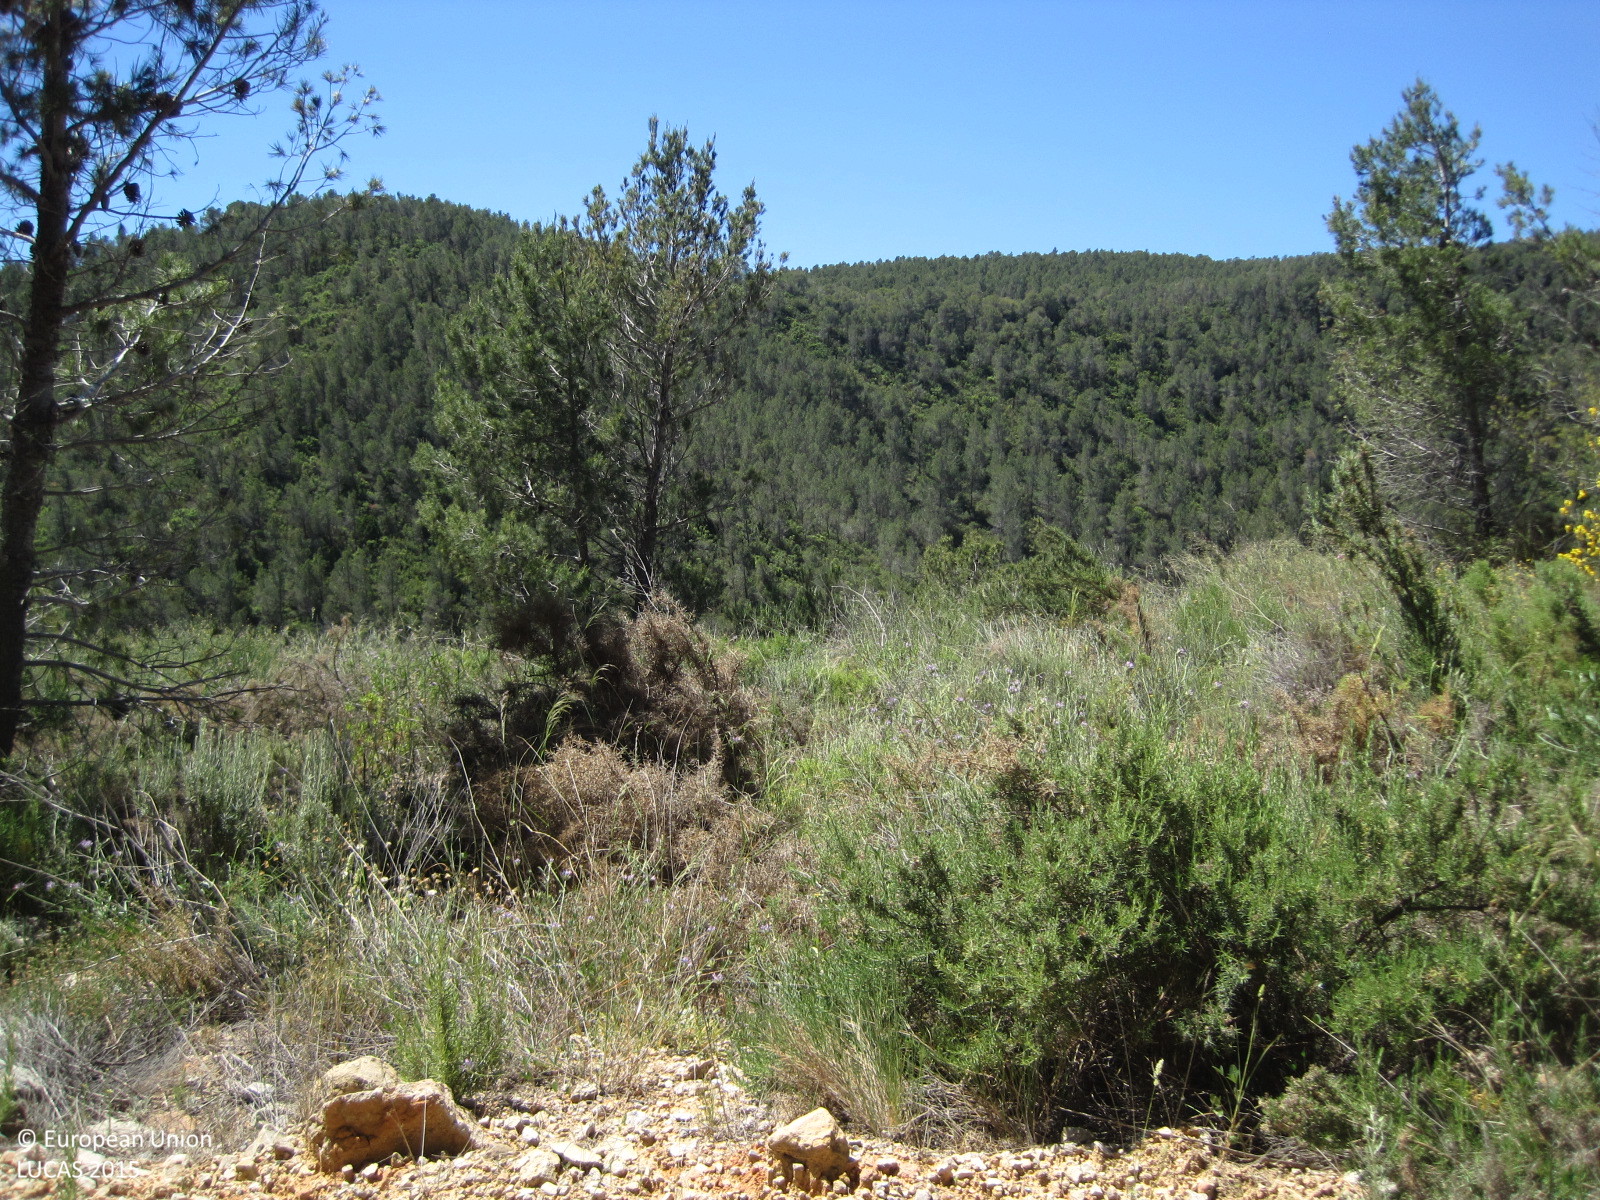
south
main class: Artificial land
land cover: Non built-up linear features
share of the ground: > 75 %
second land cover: Grassland without tree/shrub cover
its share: > 75 %
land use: Road transport
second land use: Forestry
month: May
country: ES
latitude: 39.4305
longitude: -0.8148
